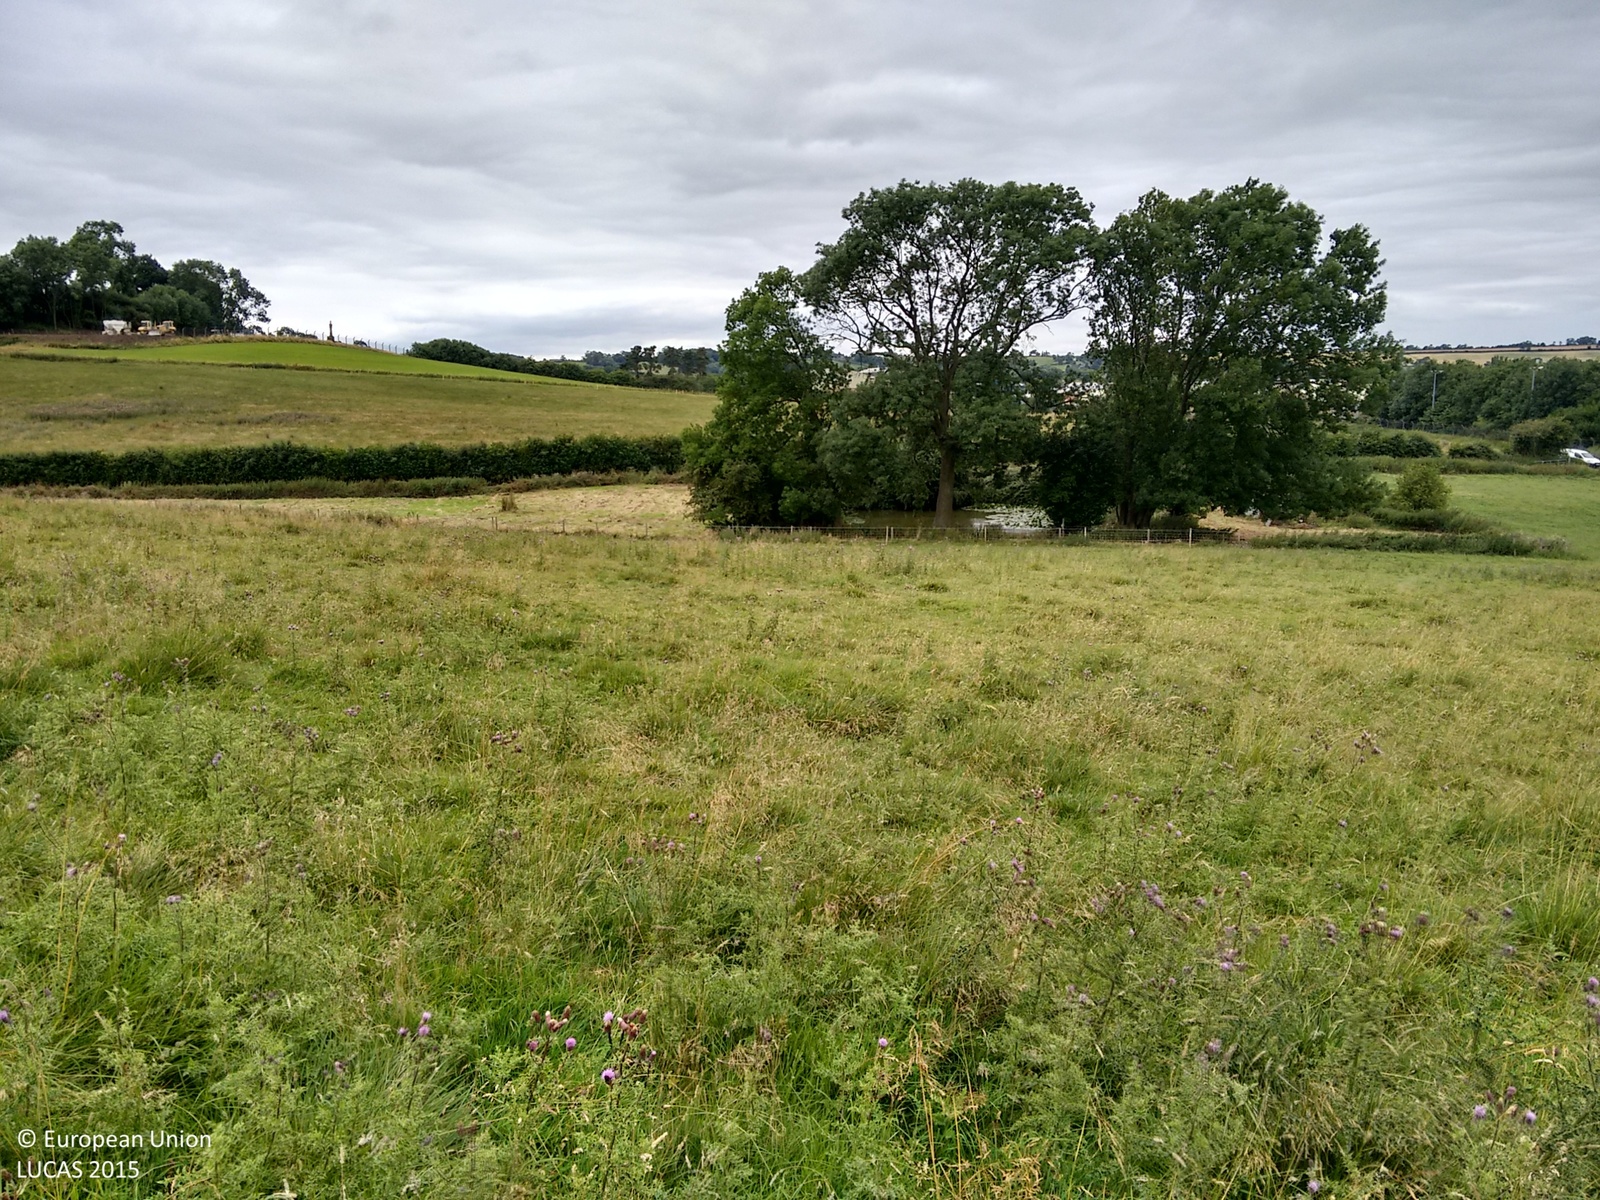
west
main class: Grassland
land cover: Grassland without tree/shrub cover
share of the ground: > 75 %
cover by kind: herbaceous plants 100 %
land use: Agriculture (excluding fallow land and kitchen gardens)
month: July
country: GB
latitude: 52.8105
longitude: -0.9776
